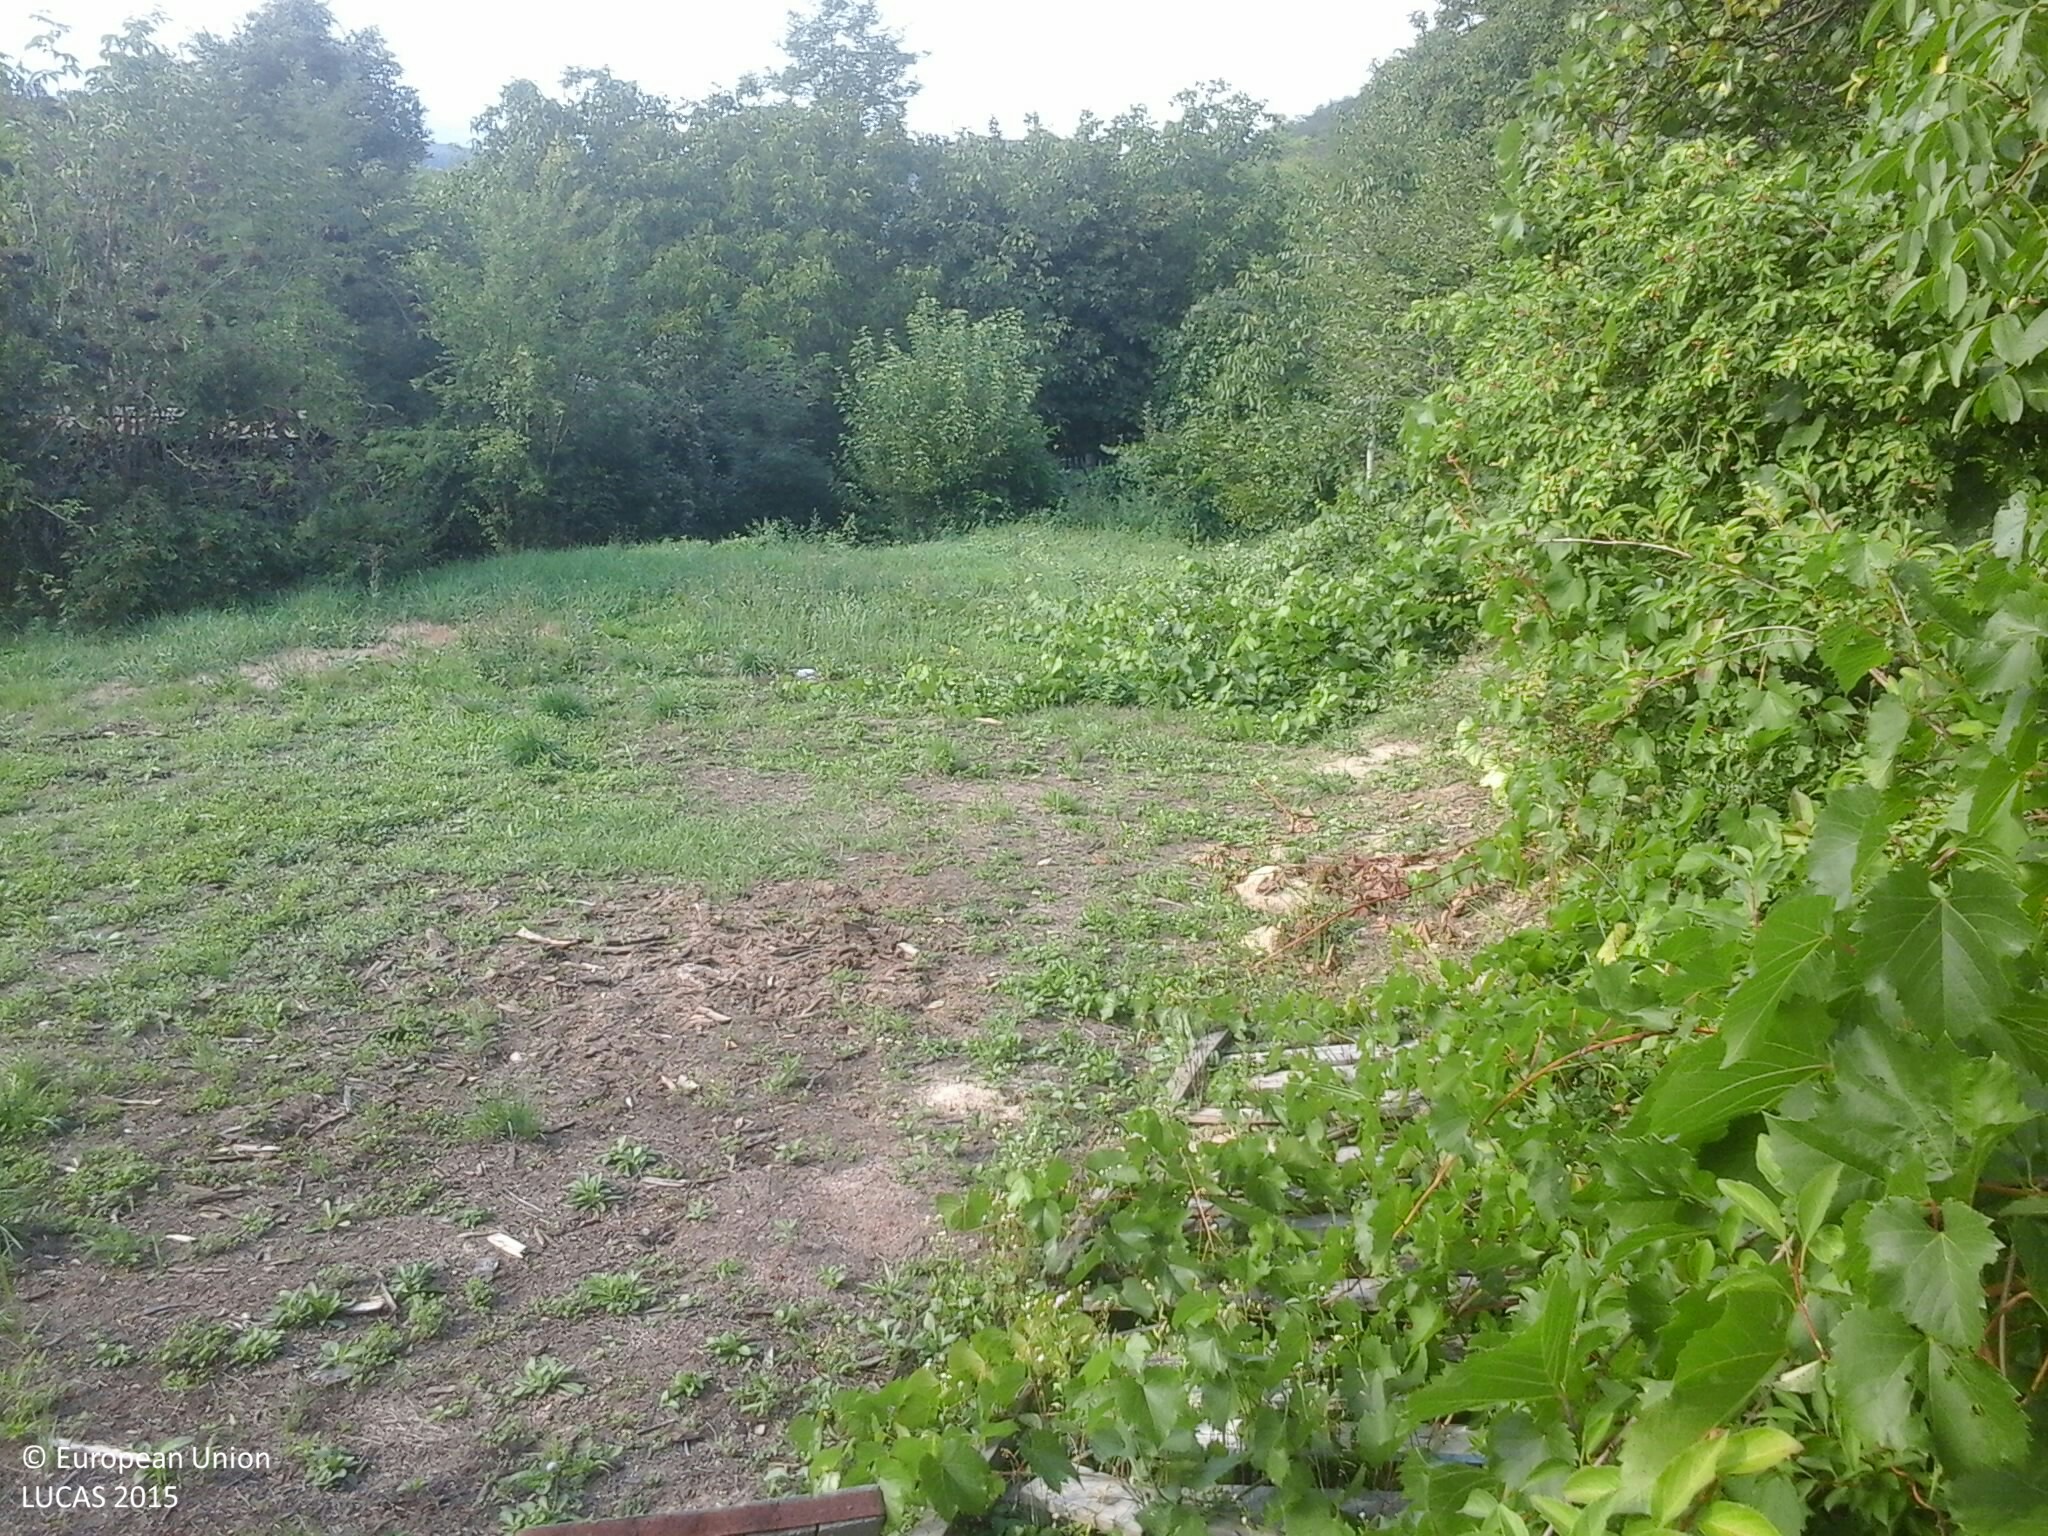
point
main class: Grassland
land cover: Spontaneously vegetated surfaces
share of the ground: > 75 %
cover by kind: herbaceous plants 100 %
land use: Residential
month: August
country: HU
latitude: 48.0254
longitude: 19.3414
